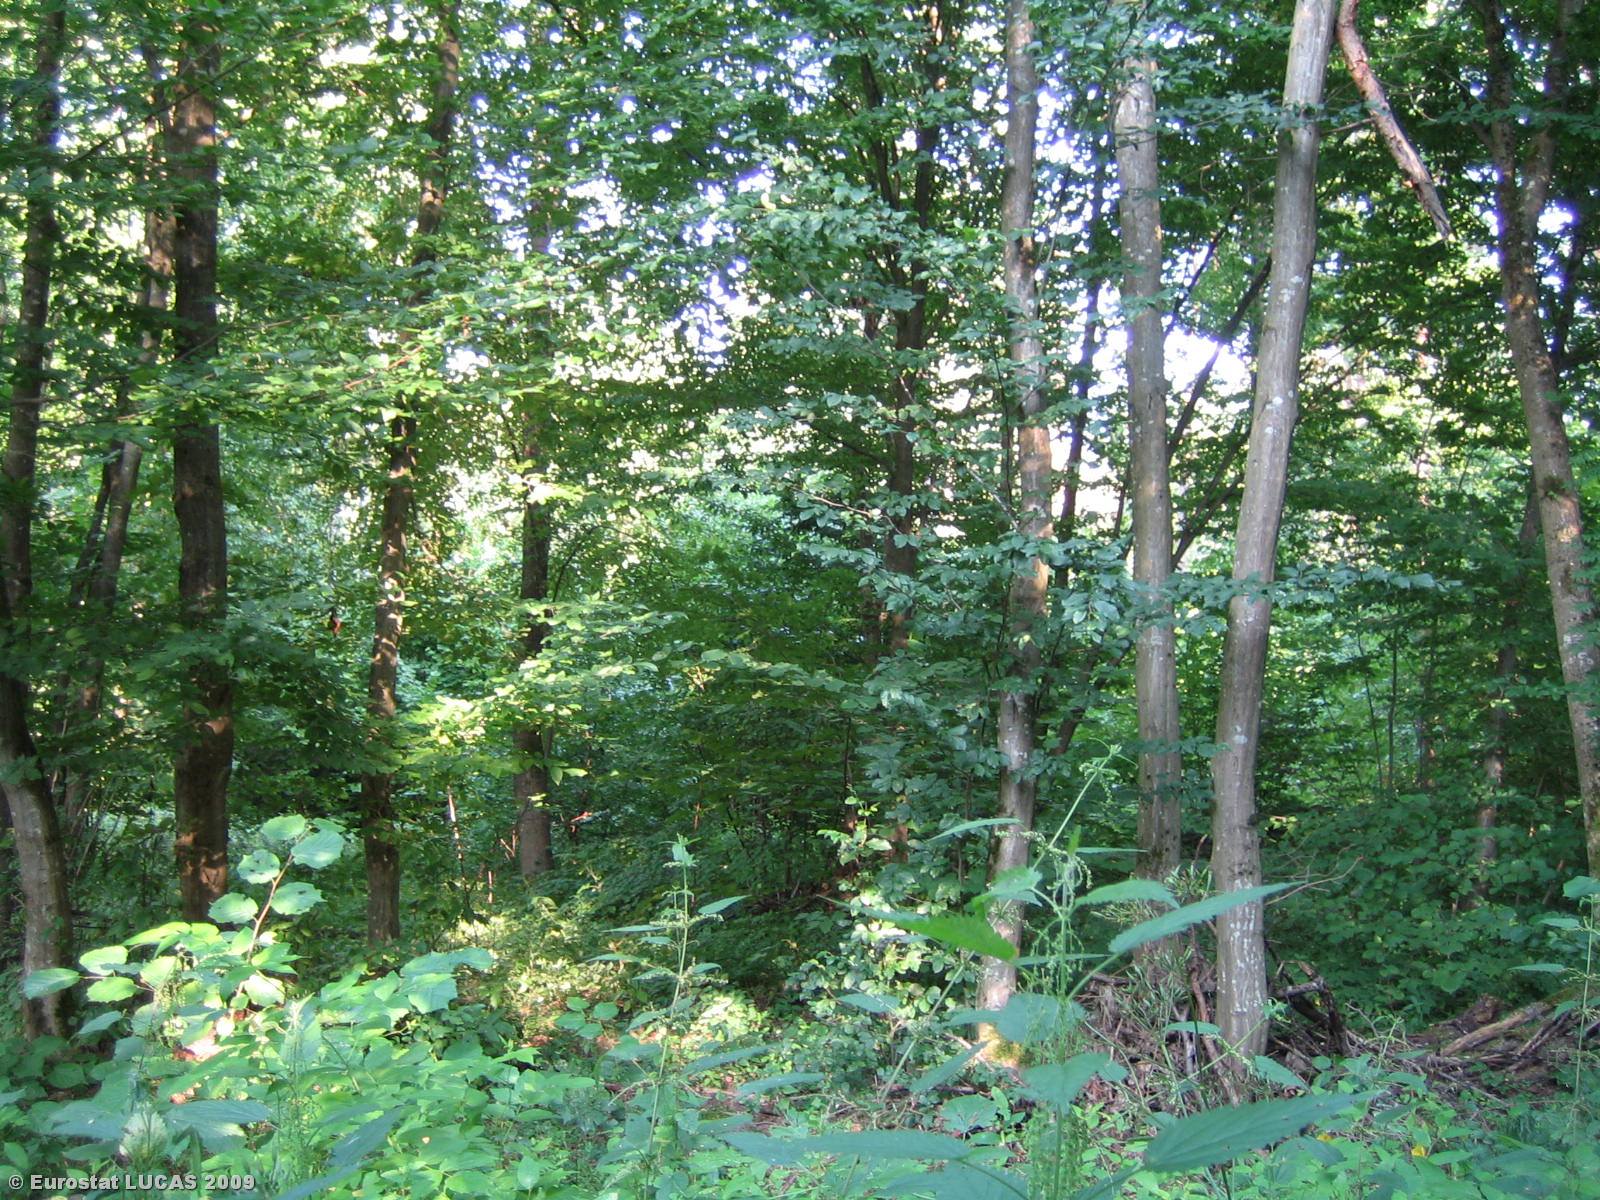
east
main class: Woodland
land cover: Mixed woodland
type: hemiboreal forest and nemoral coniferous forest and mixed broadleaved-coniferous forest
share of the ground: > 75 %
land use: Forestry
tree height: > 5 m
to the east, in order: Mixed woodland
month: August
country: LT
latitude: 54.6656
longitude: 24.4744
